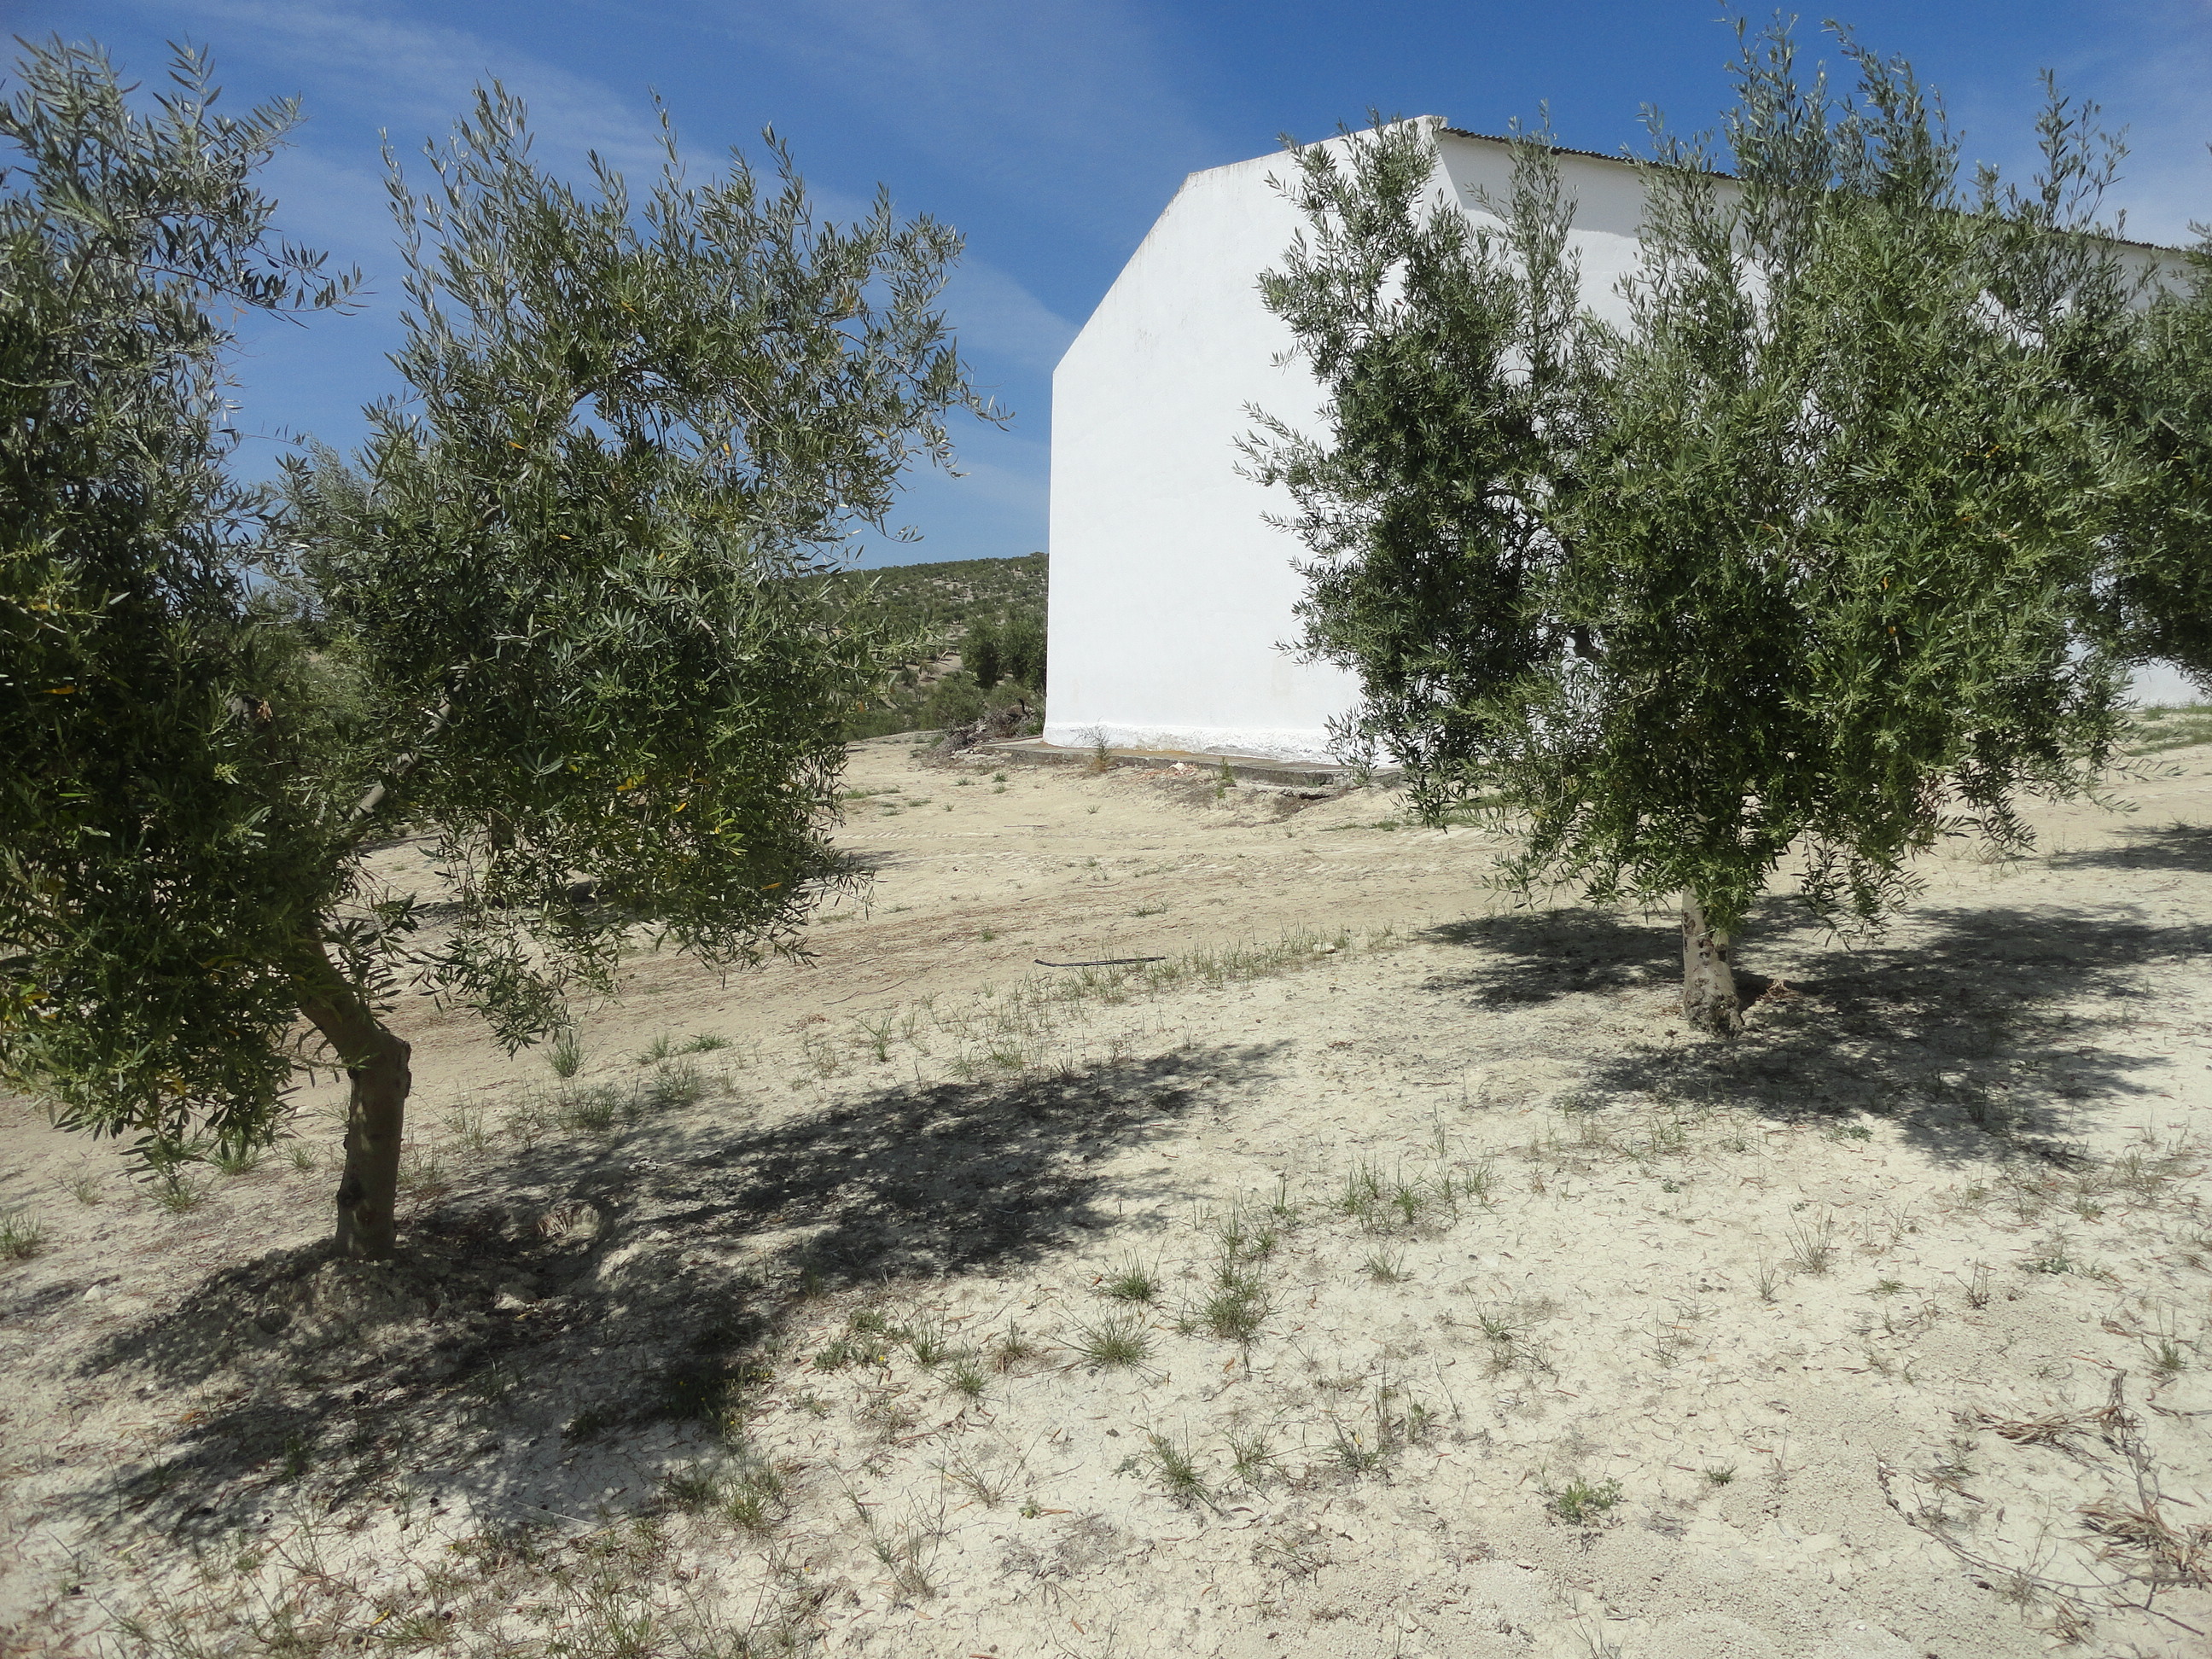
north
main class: Cropland
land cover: Olive groves
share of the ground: 50 - 75 %
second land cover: Spontaneously vegetated surfaces
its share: 10 - 25 %
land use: Agriculture (excluding fallow land and kitchen gardens)
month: April
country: ES
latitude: 37.6189
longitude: -4.4050
